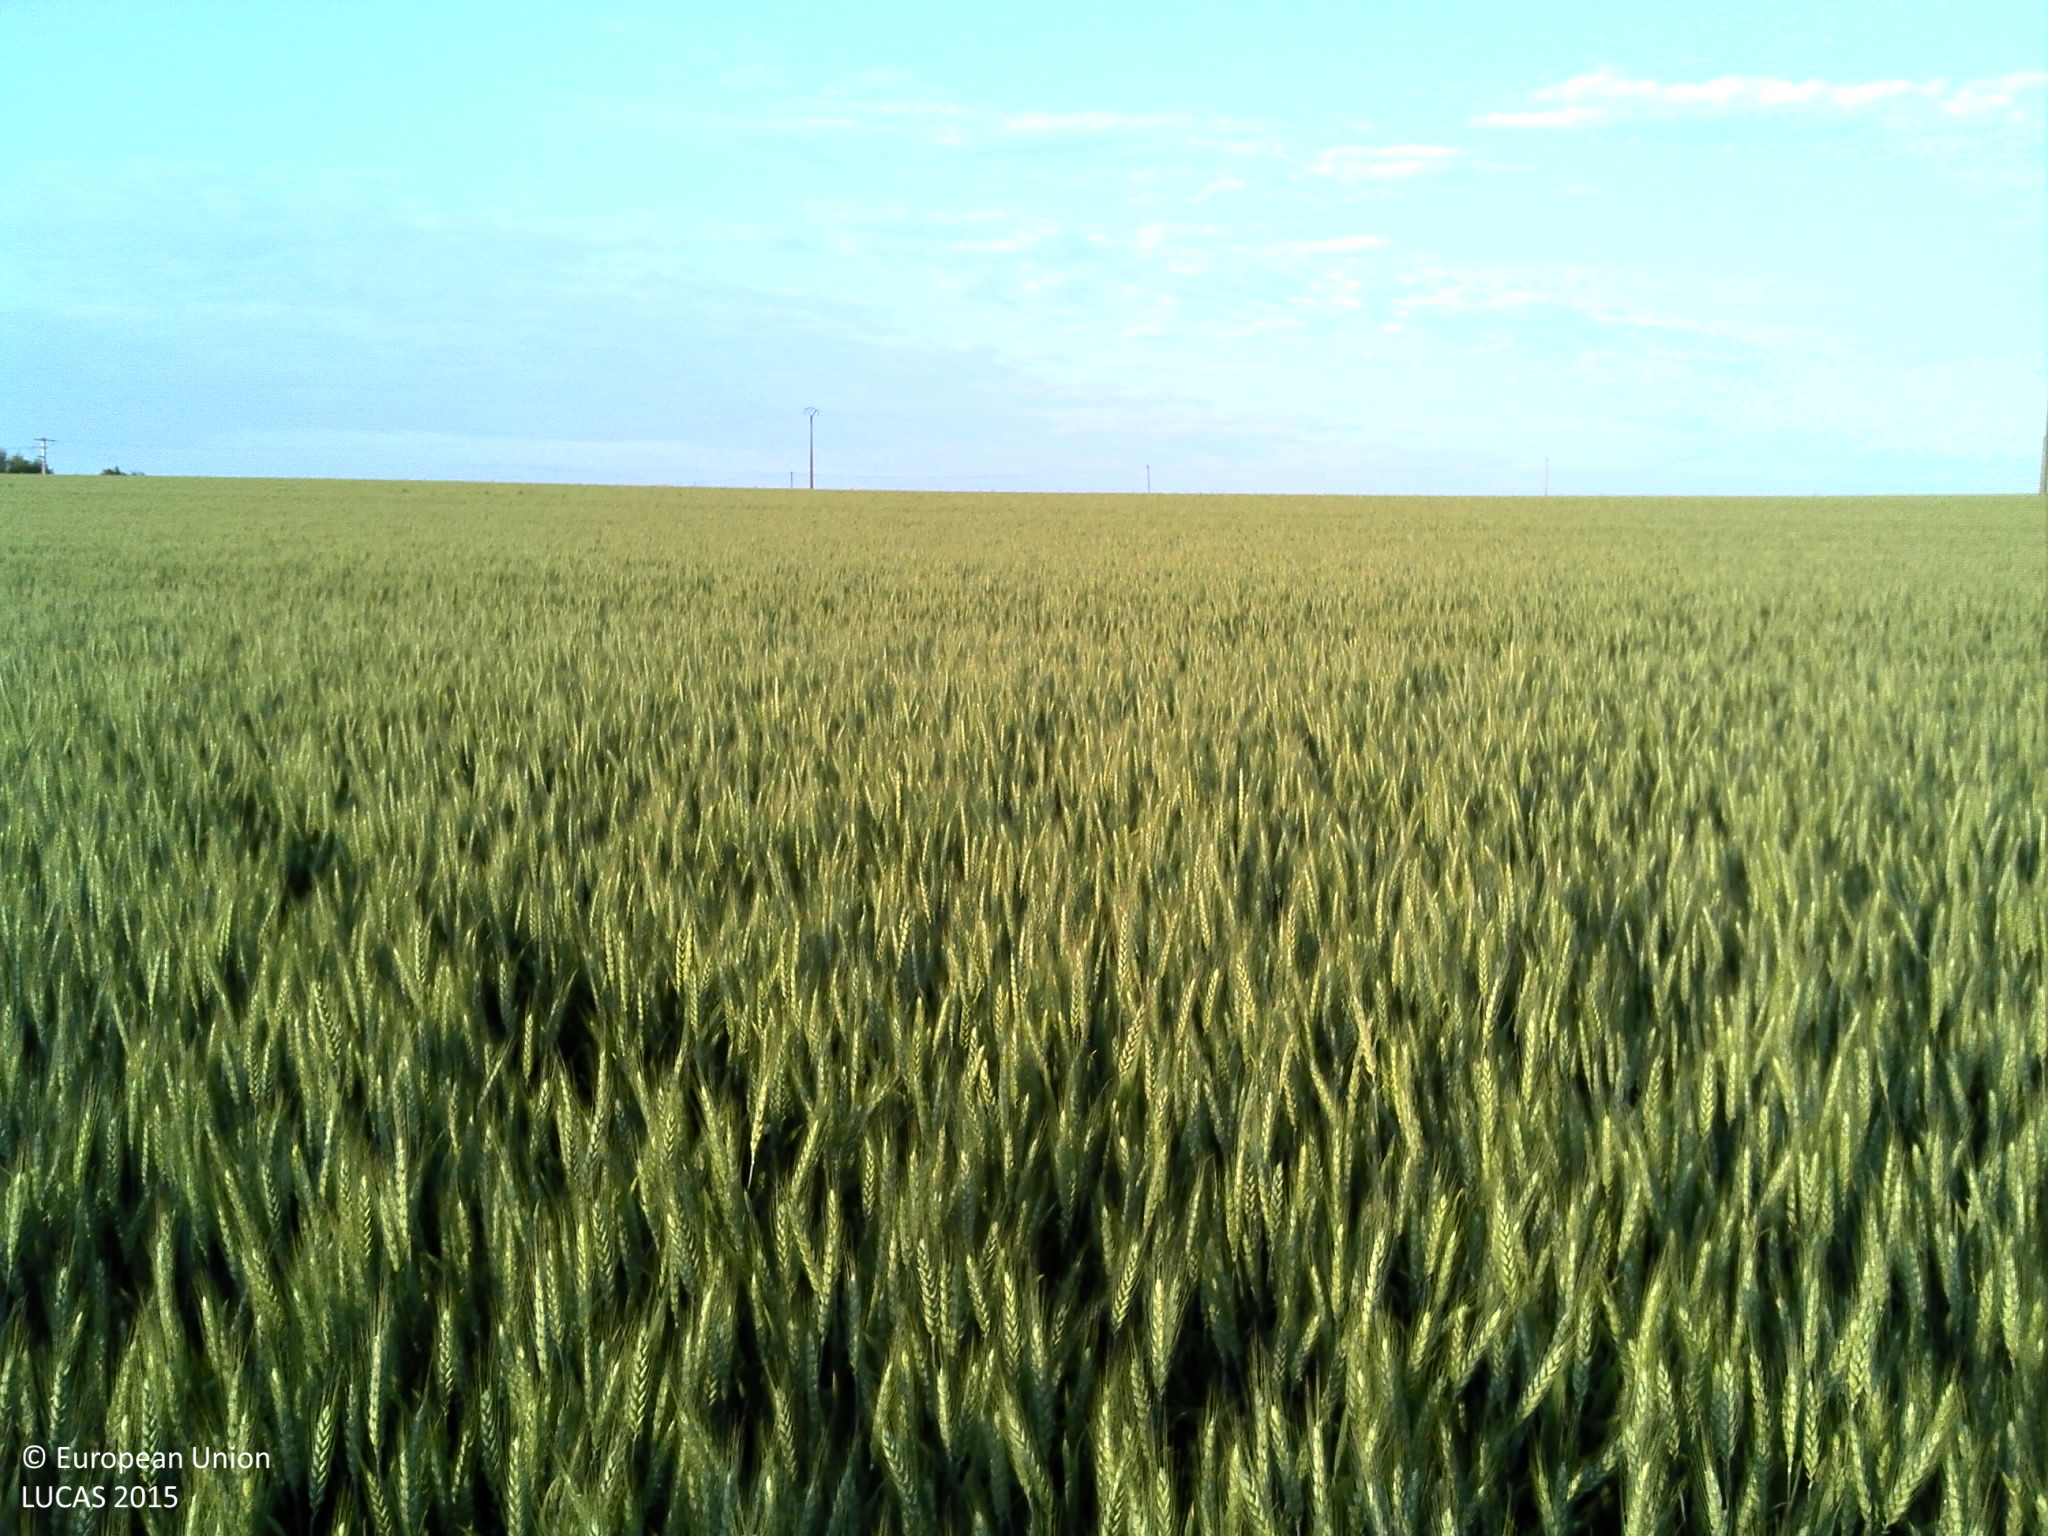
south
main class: Cropland
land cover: Durum wheat
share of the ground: > 75 %
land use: Agriculture (excluding fallow land and kitchen gardens)
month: June
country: FR
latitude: 49.6815
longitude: 0.9825
